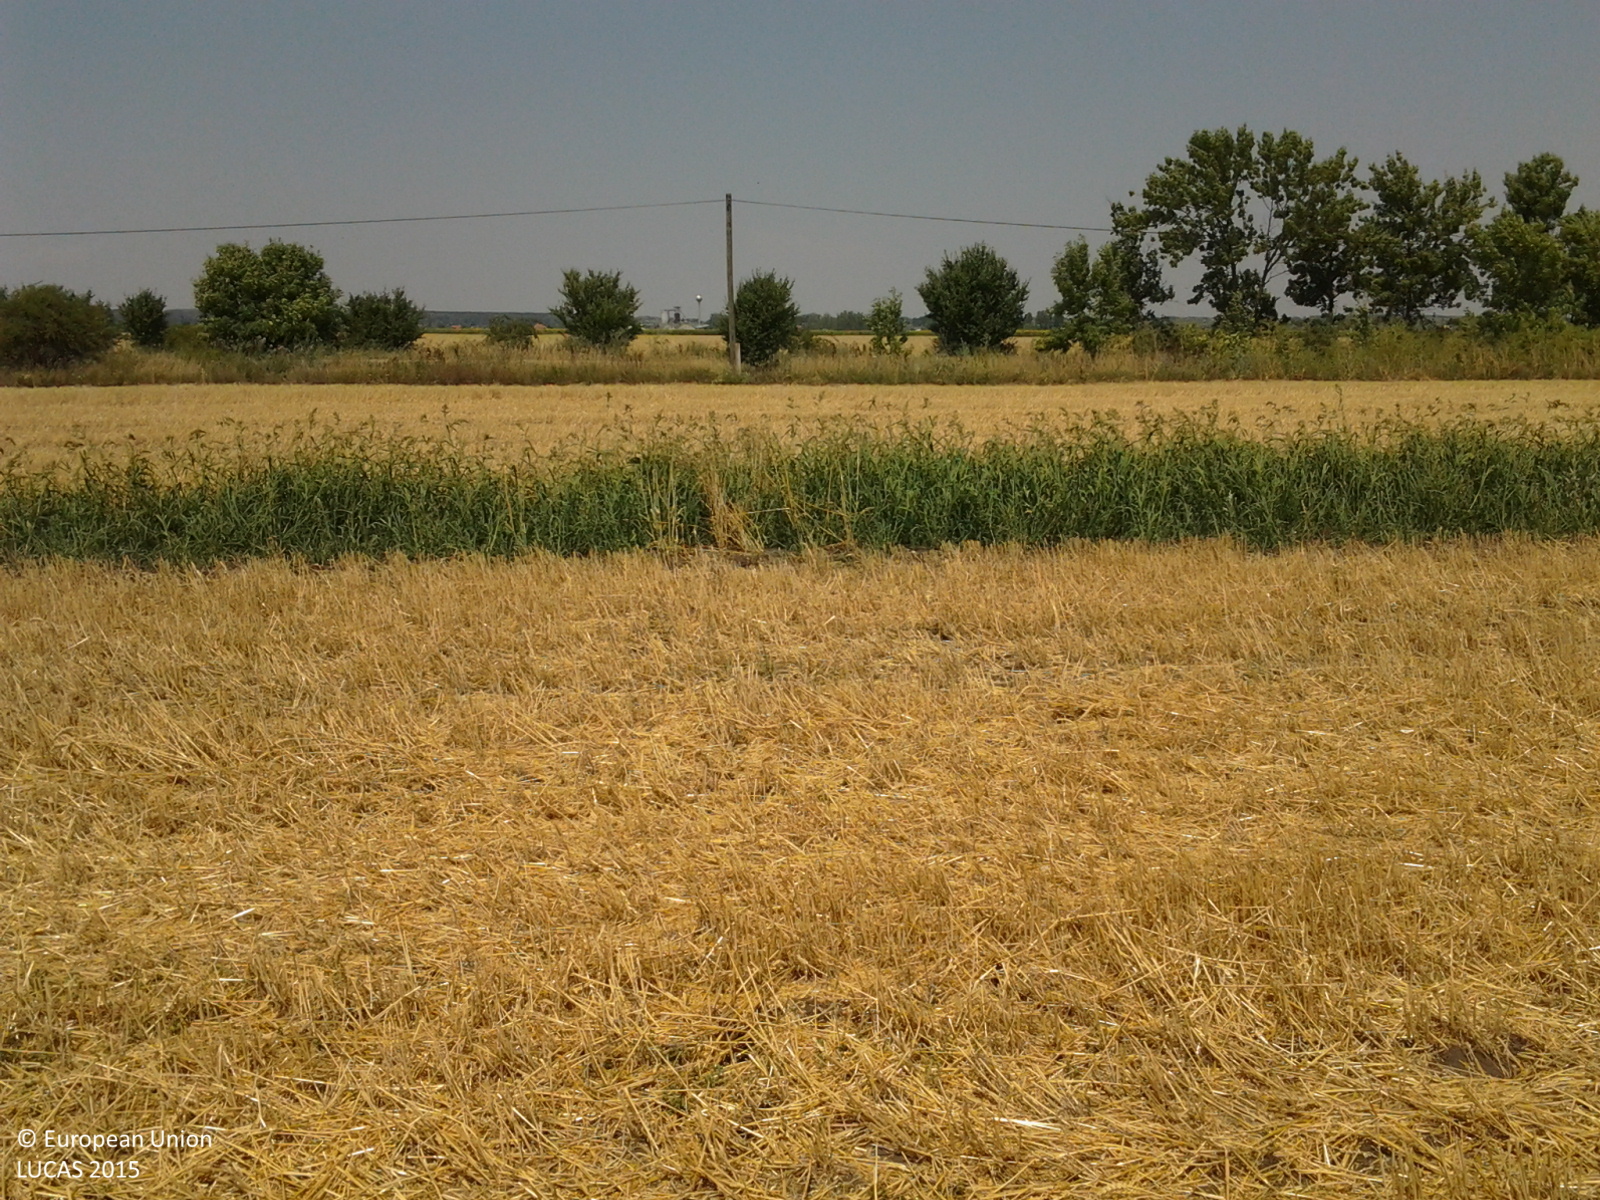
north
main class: Cropland
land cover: Common wheat
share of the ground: 10 - 25 %
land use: Agriculture (excluding fallow land and kitchen gardens)
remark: Harvested field
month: July
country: HU
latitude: 47.3676
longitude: 20.3979
